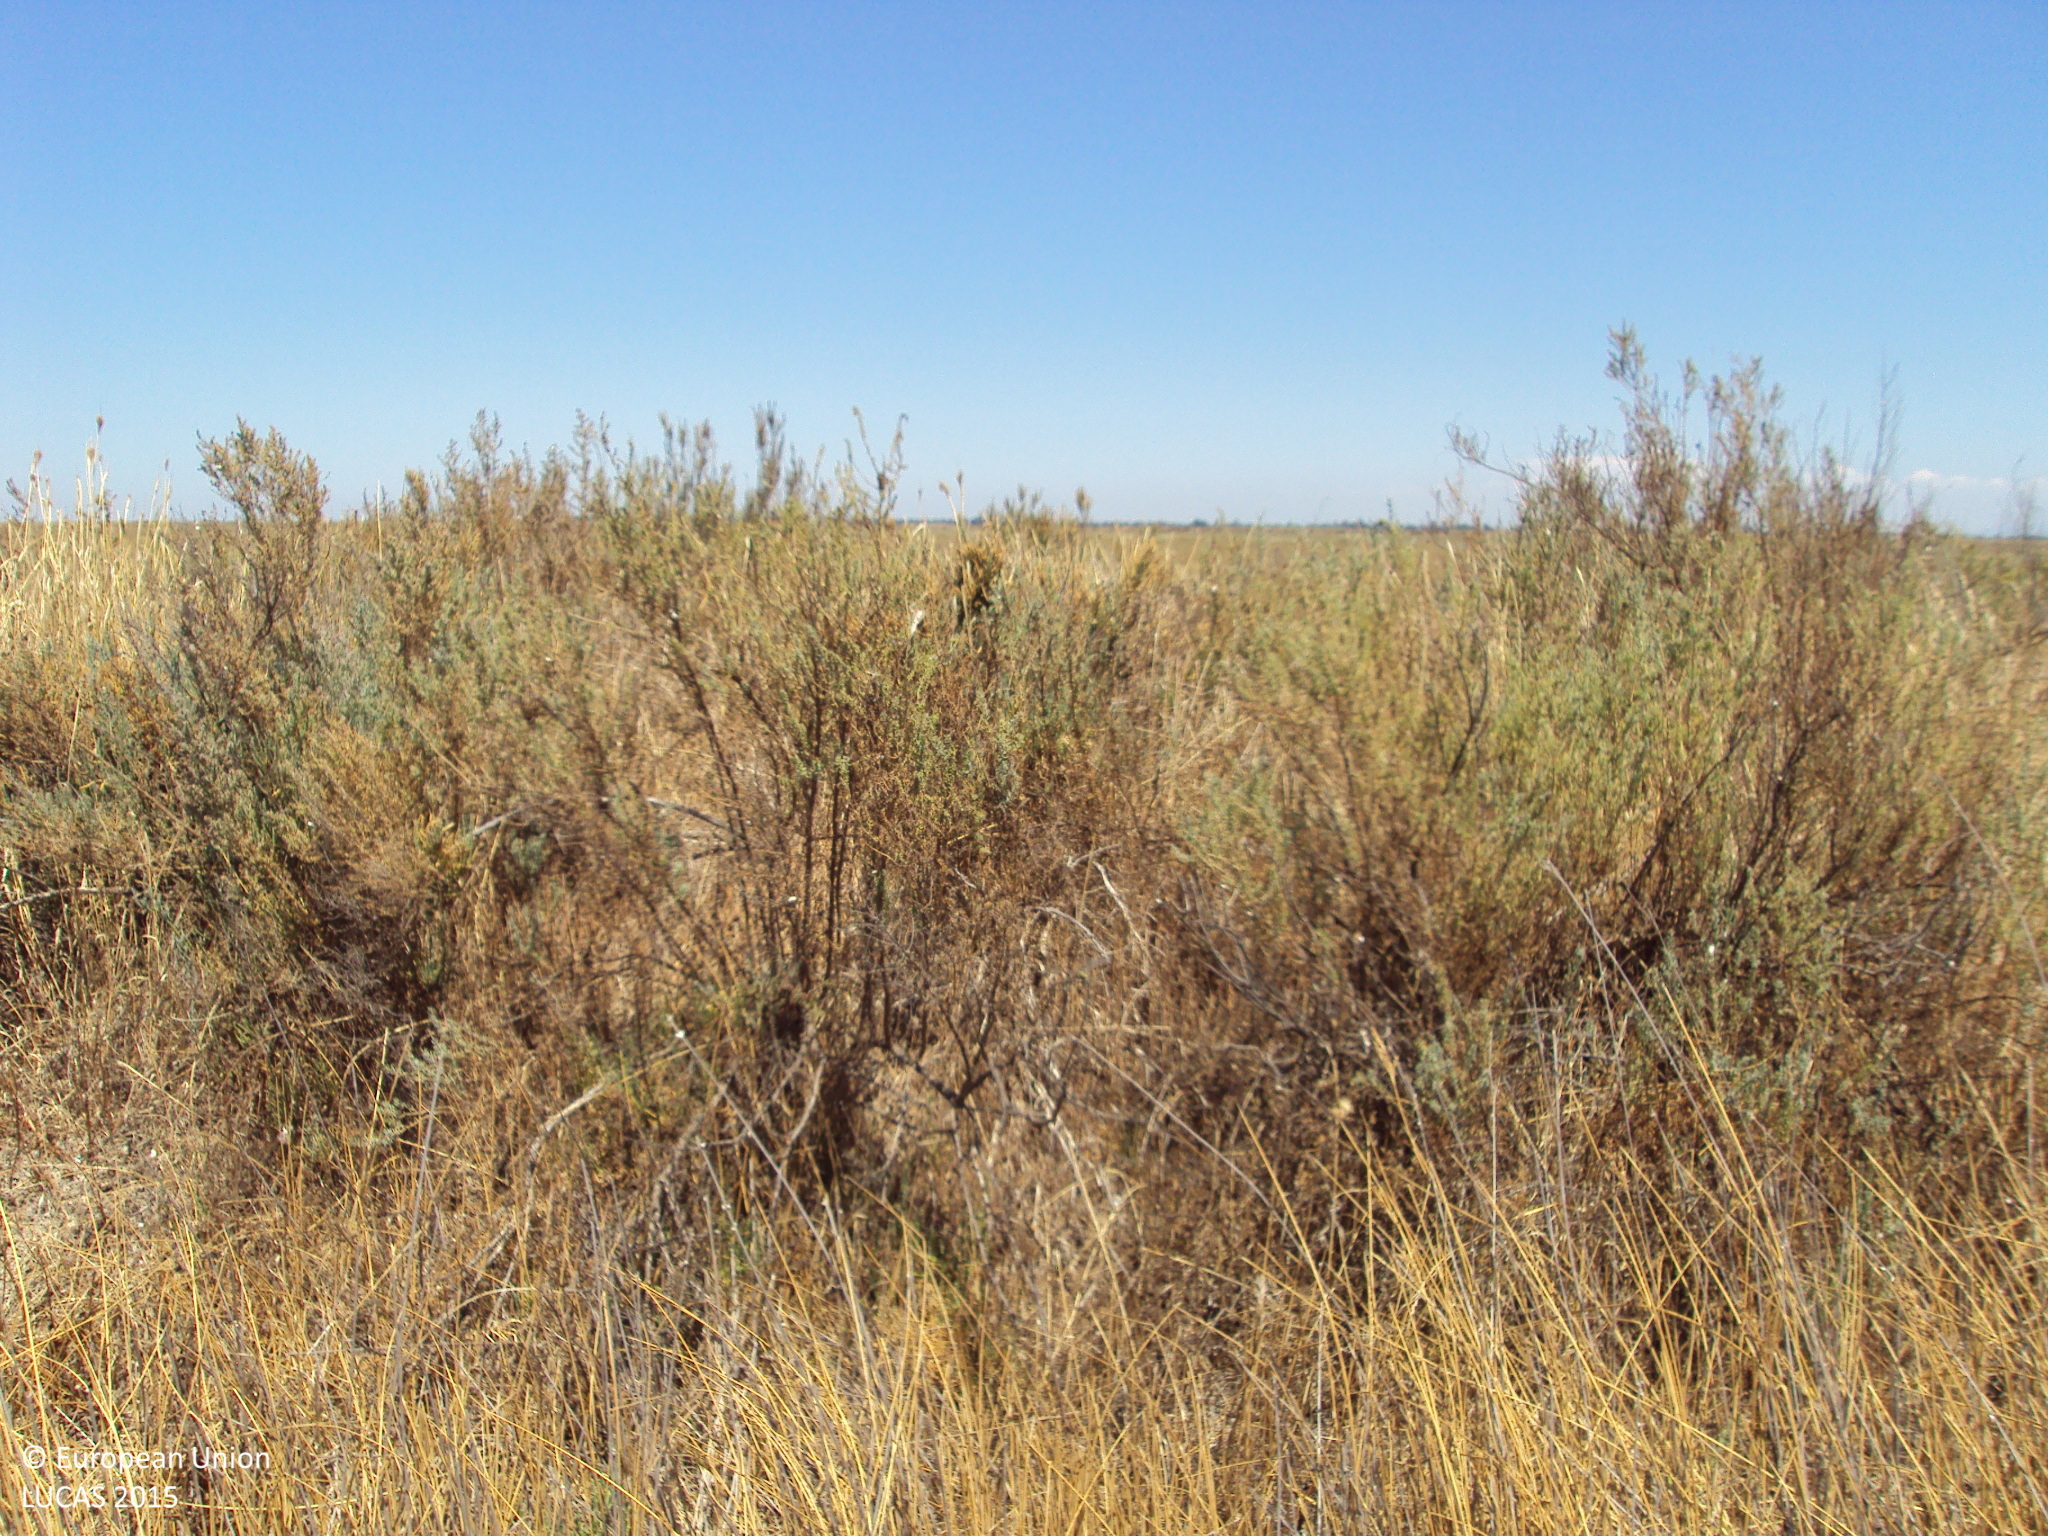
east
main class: Grassland
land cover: Grassland without tree/shrub cover
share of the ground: > 75 %
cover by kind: herbaceous plants 100 %
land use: Semi-natural and natural areas not in use
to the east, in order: Grass margins; Grassland without tree/shrub cover; Other bare soil
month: July
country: ES
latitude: 36.9924
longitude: -6.2105
